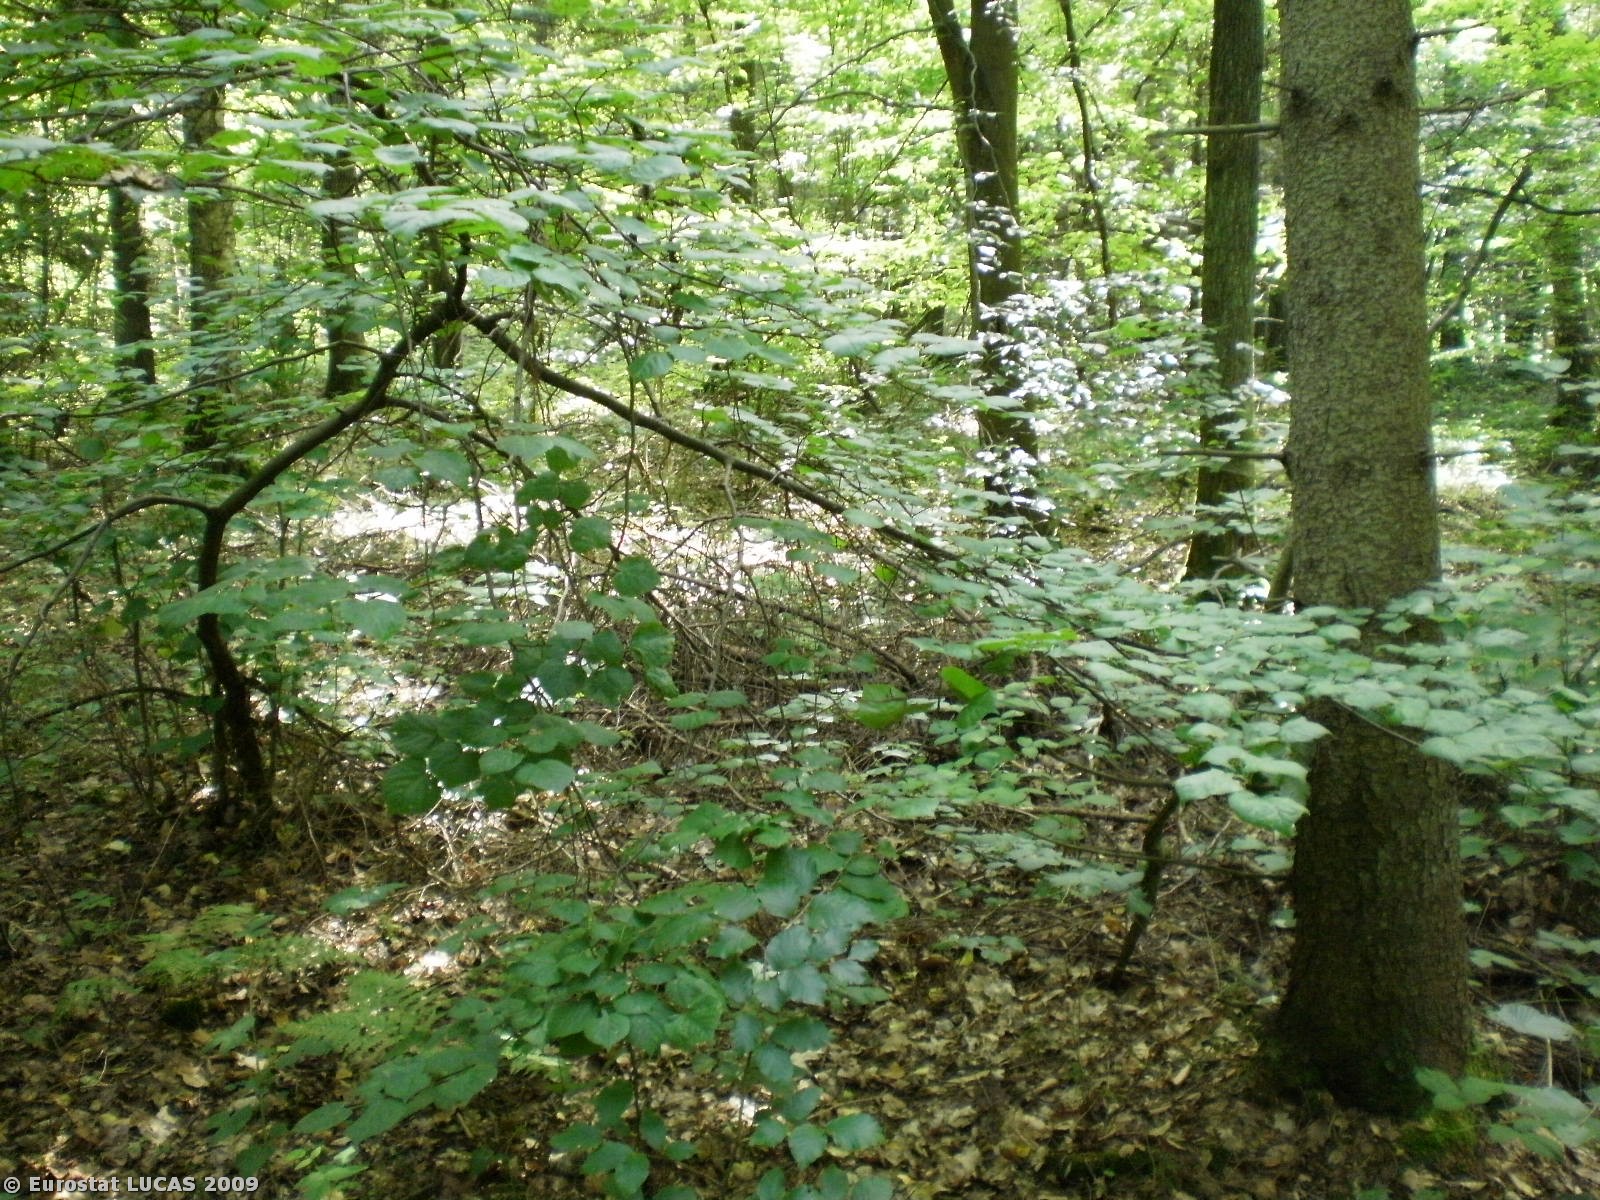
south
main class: Woodland
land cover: Mixed woodland
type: hemiboreal forest and nemoral coniferous forest and mixed broadleaved-coniferous forest
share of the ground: > 75 %
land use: Forestry
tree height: > 5 m
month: July
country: PL
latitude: 53.8828
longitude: 19.9034
